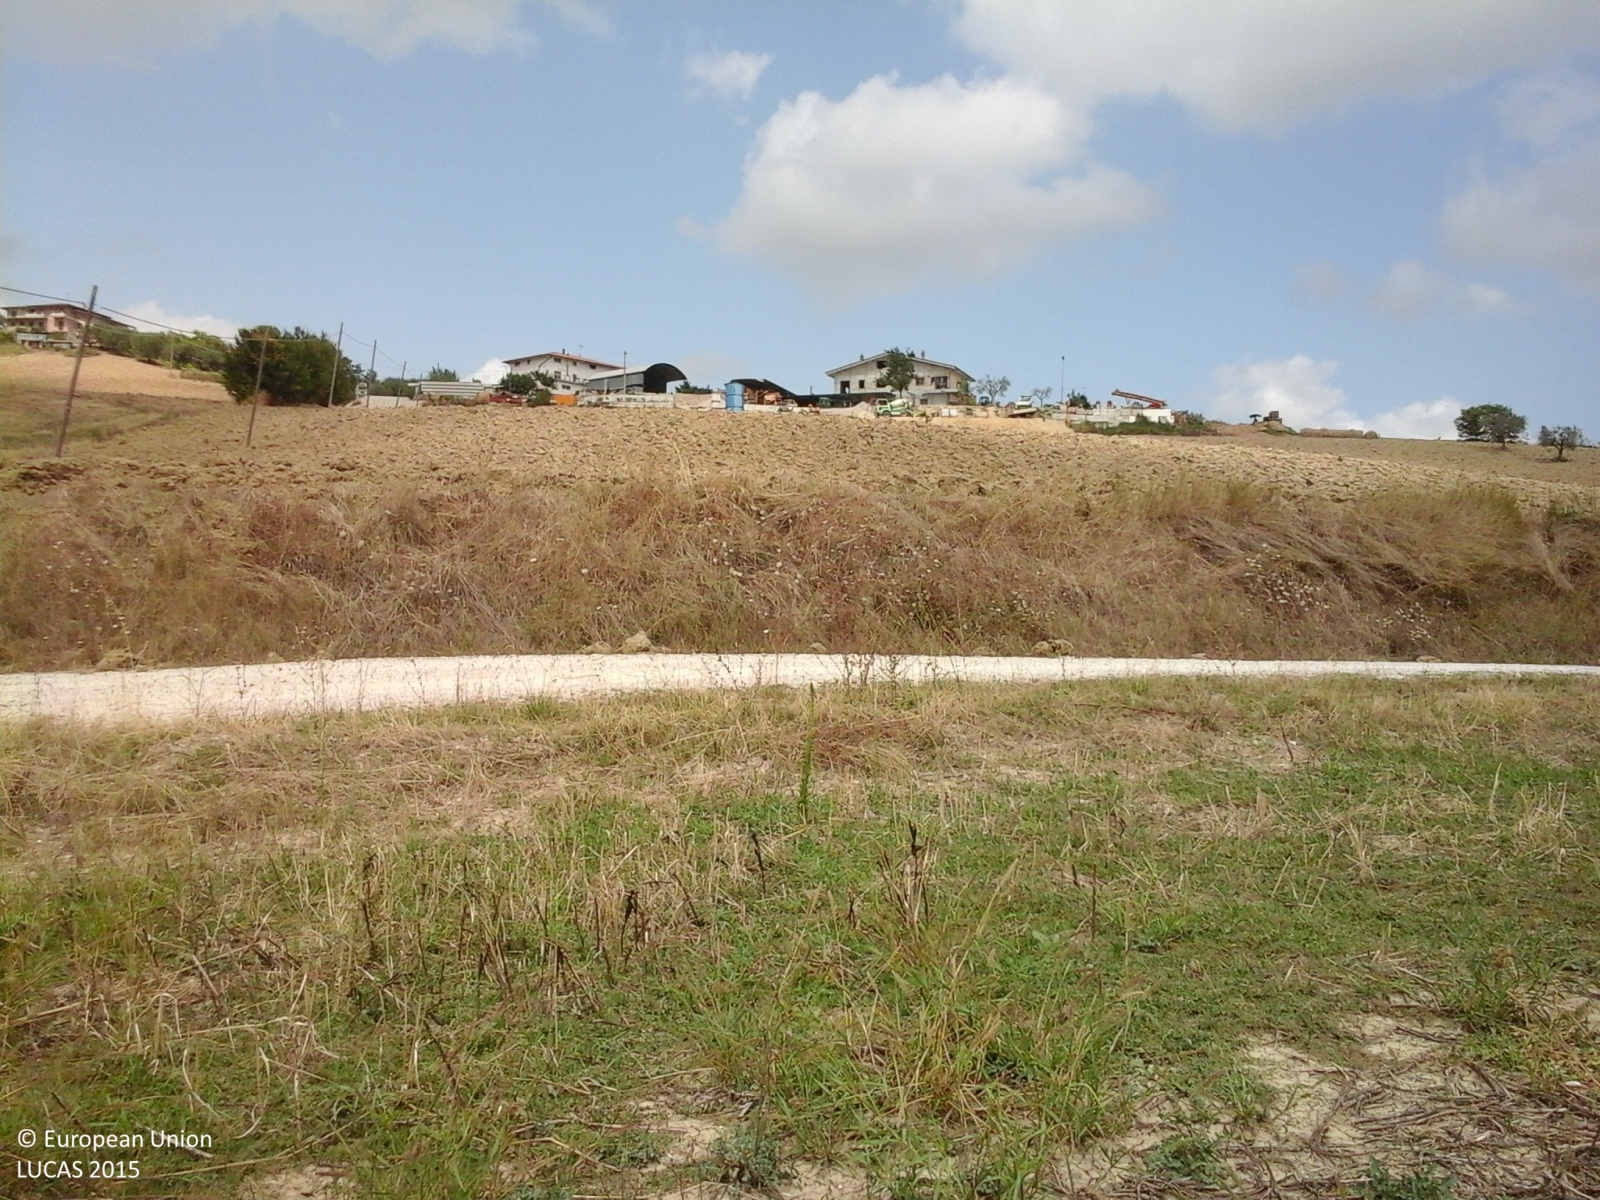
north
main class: Cropland
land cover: Dry pulses
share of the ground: < 10 %
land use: Agriculture (excluding fallow land and kitchen gardens)
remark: Harvested field
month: August
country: IT
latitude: 42.7269
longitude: 13.8117
